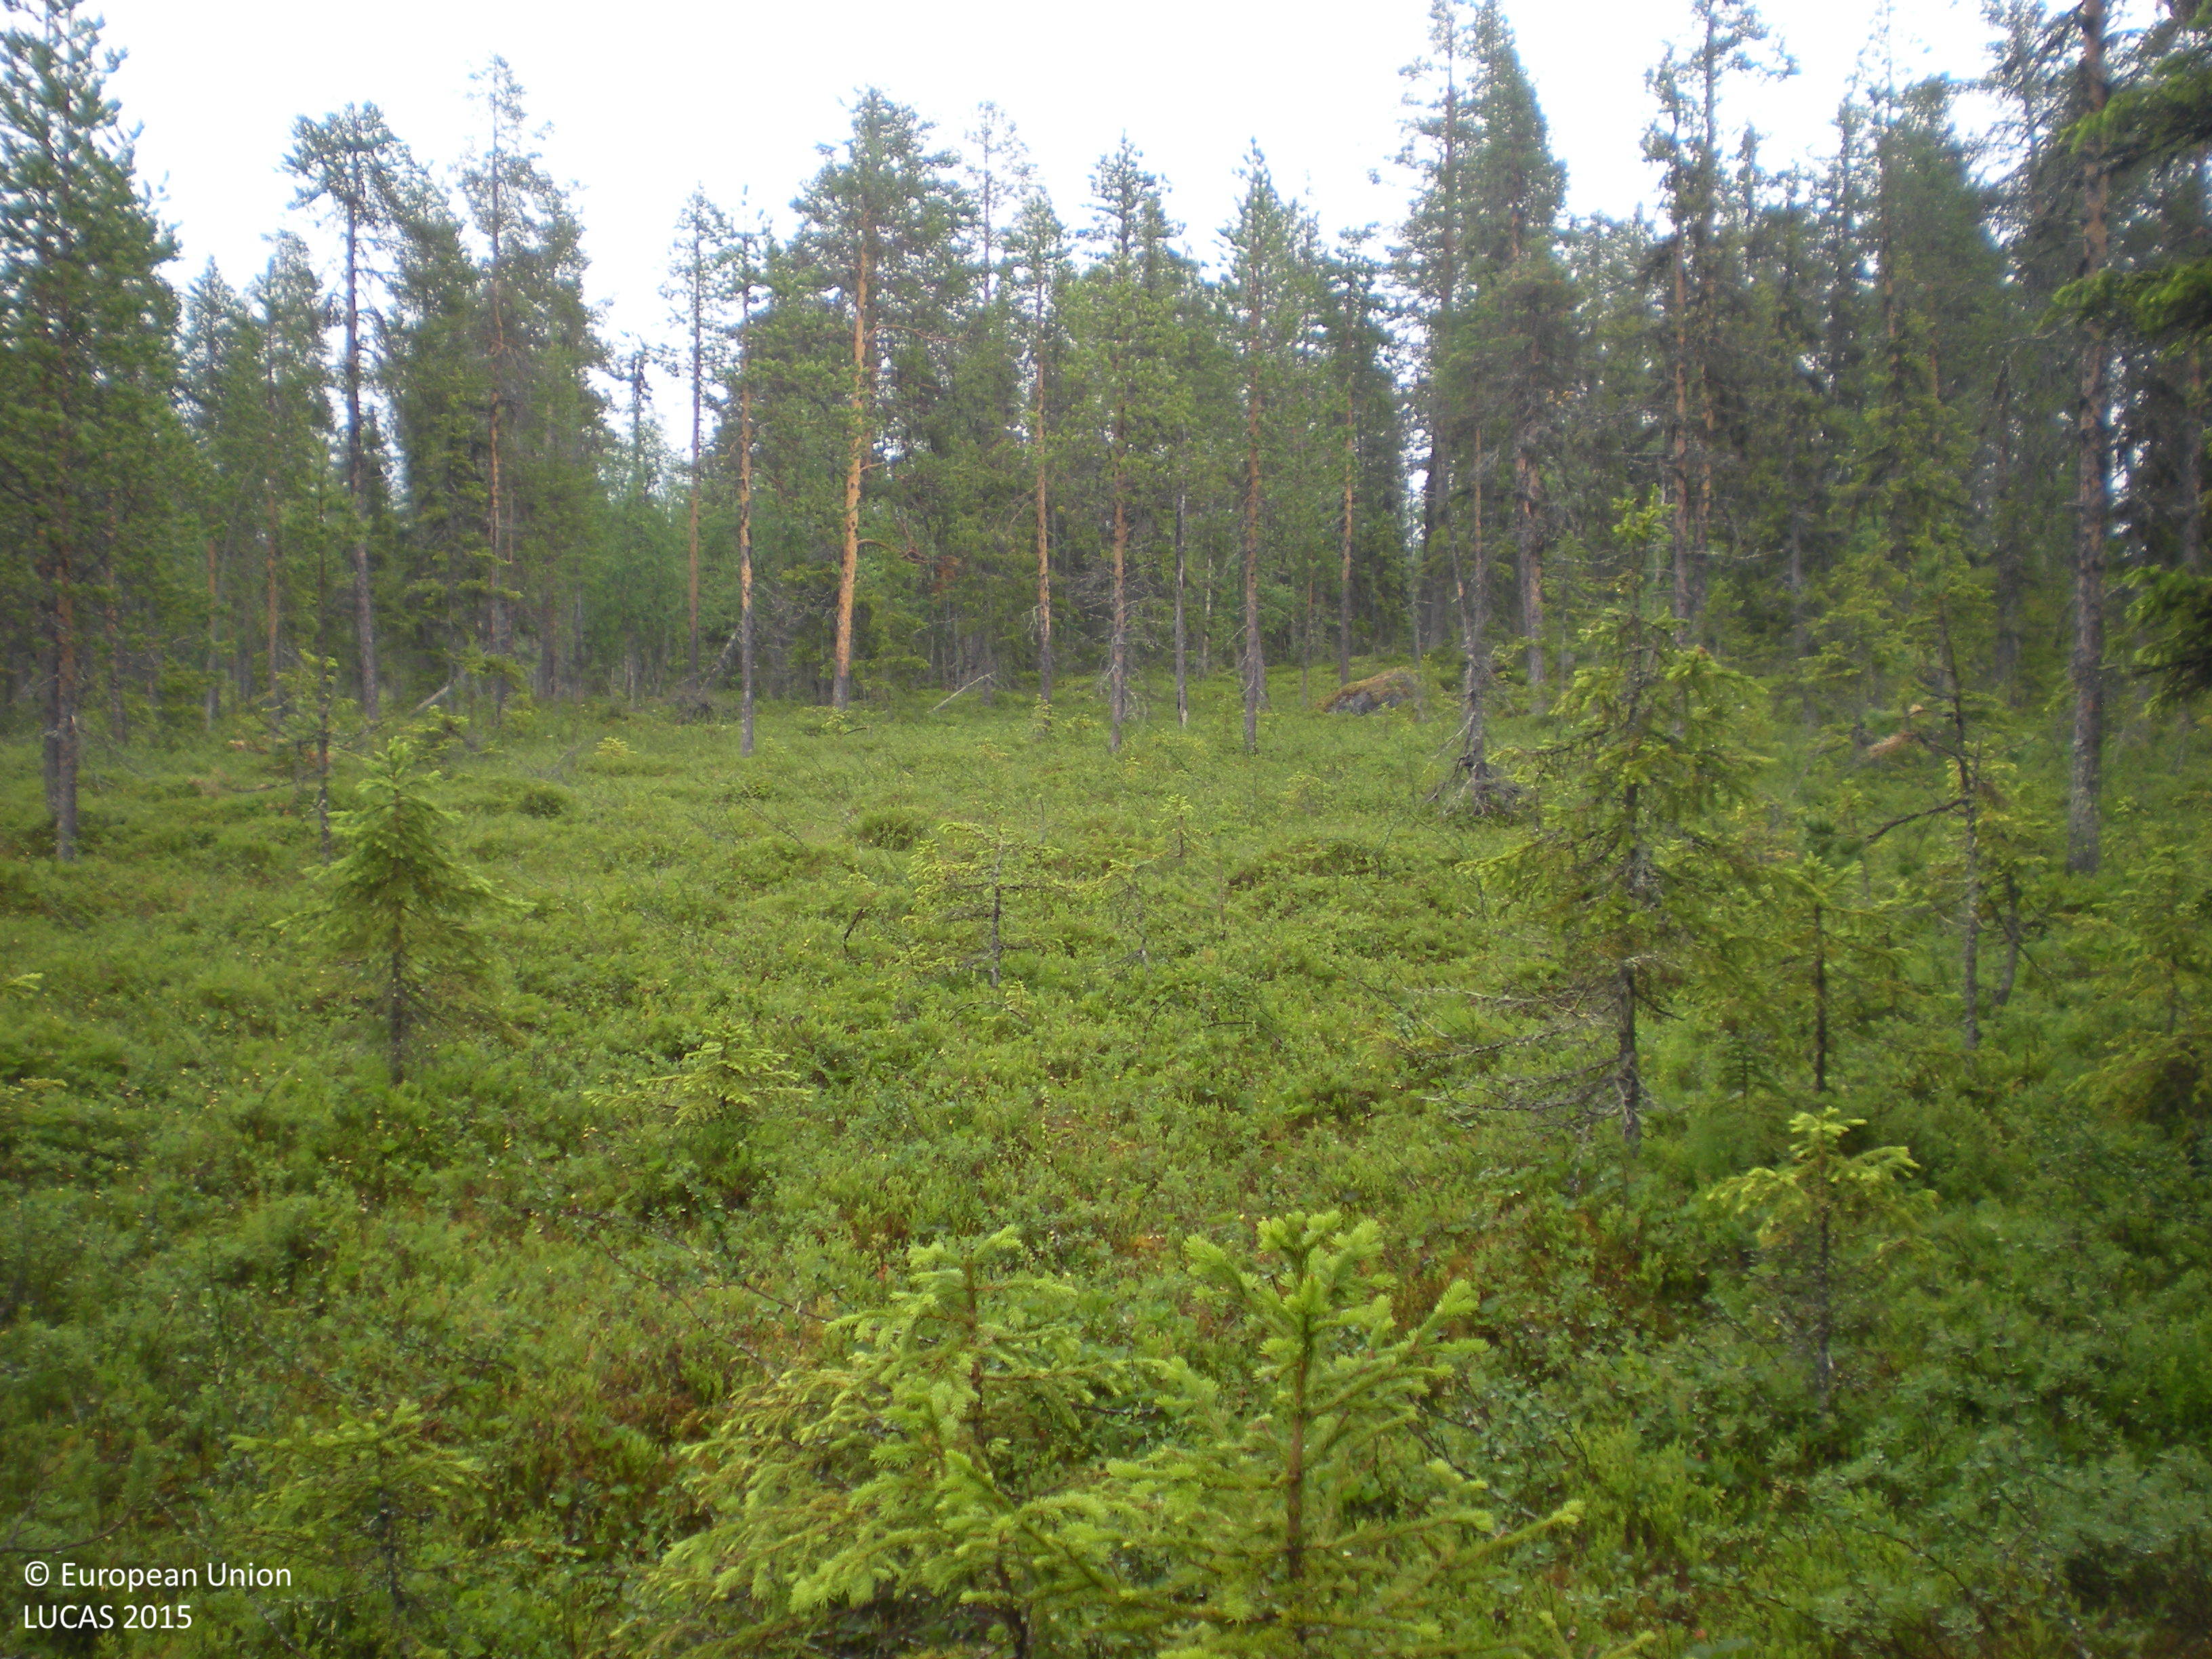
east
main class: Woodland
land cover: Other mixed woodland
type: boreal forest
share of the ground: 25 - 50 %
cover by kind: coniferous forest trees 35 %, shrubs 25 %, lichens and mosses 20 %, broadleaved forest trees 15 %, herbaceous plants 5 %
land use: Forestry
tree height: > 5 m
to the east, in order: Other mixed woodland; Pine dominated mixed woodland; Pine dominated coniferous woodland; Pine dominated mixed woodland; Electric lines; Pine dominated coniferous woodland; Other bare soil; Ditches and canals; Paved roads, cycling and walking lanes
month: July
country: SE
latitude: 65.8070
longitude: 17.7642
